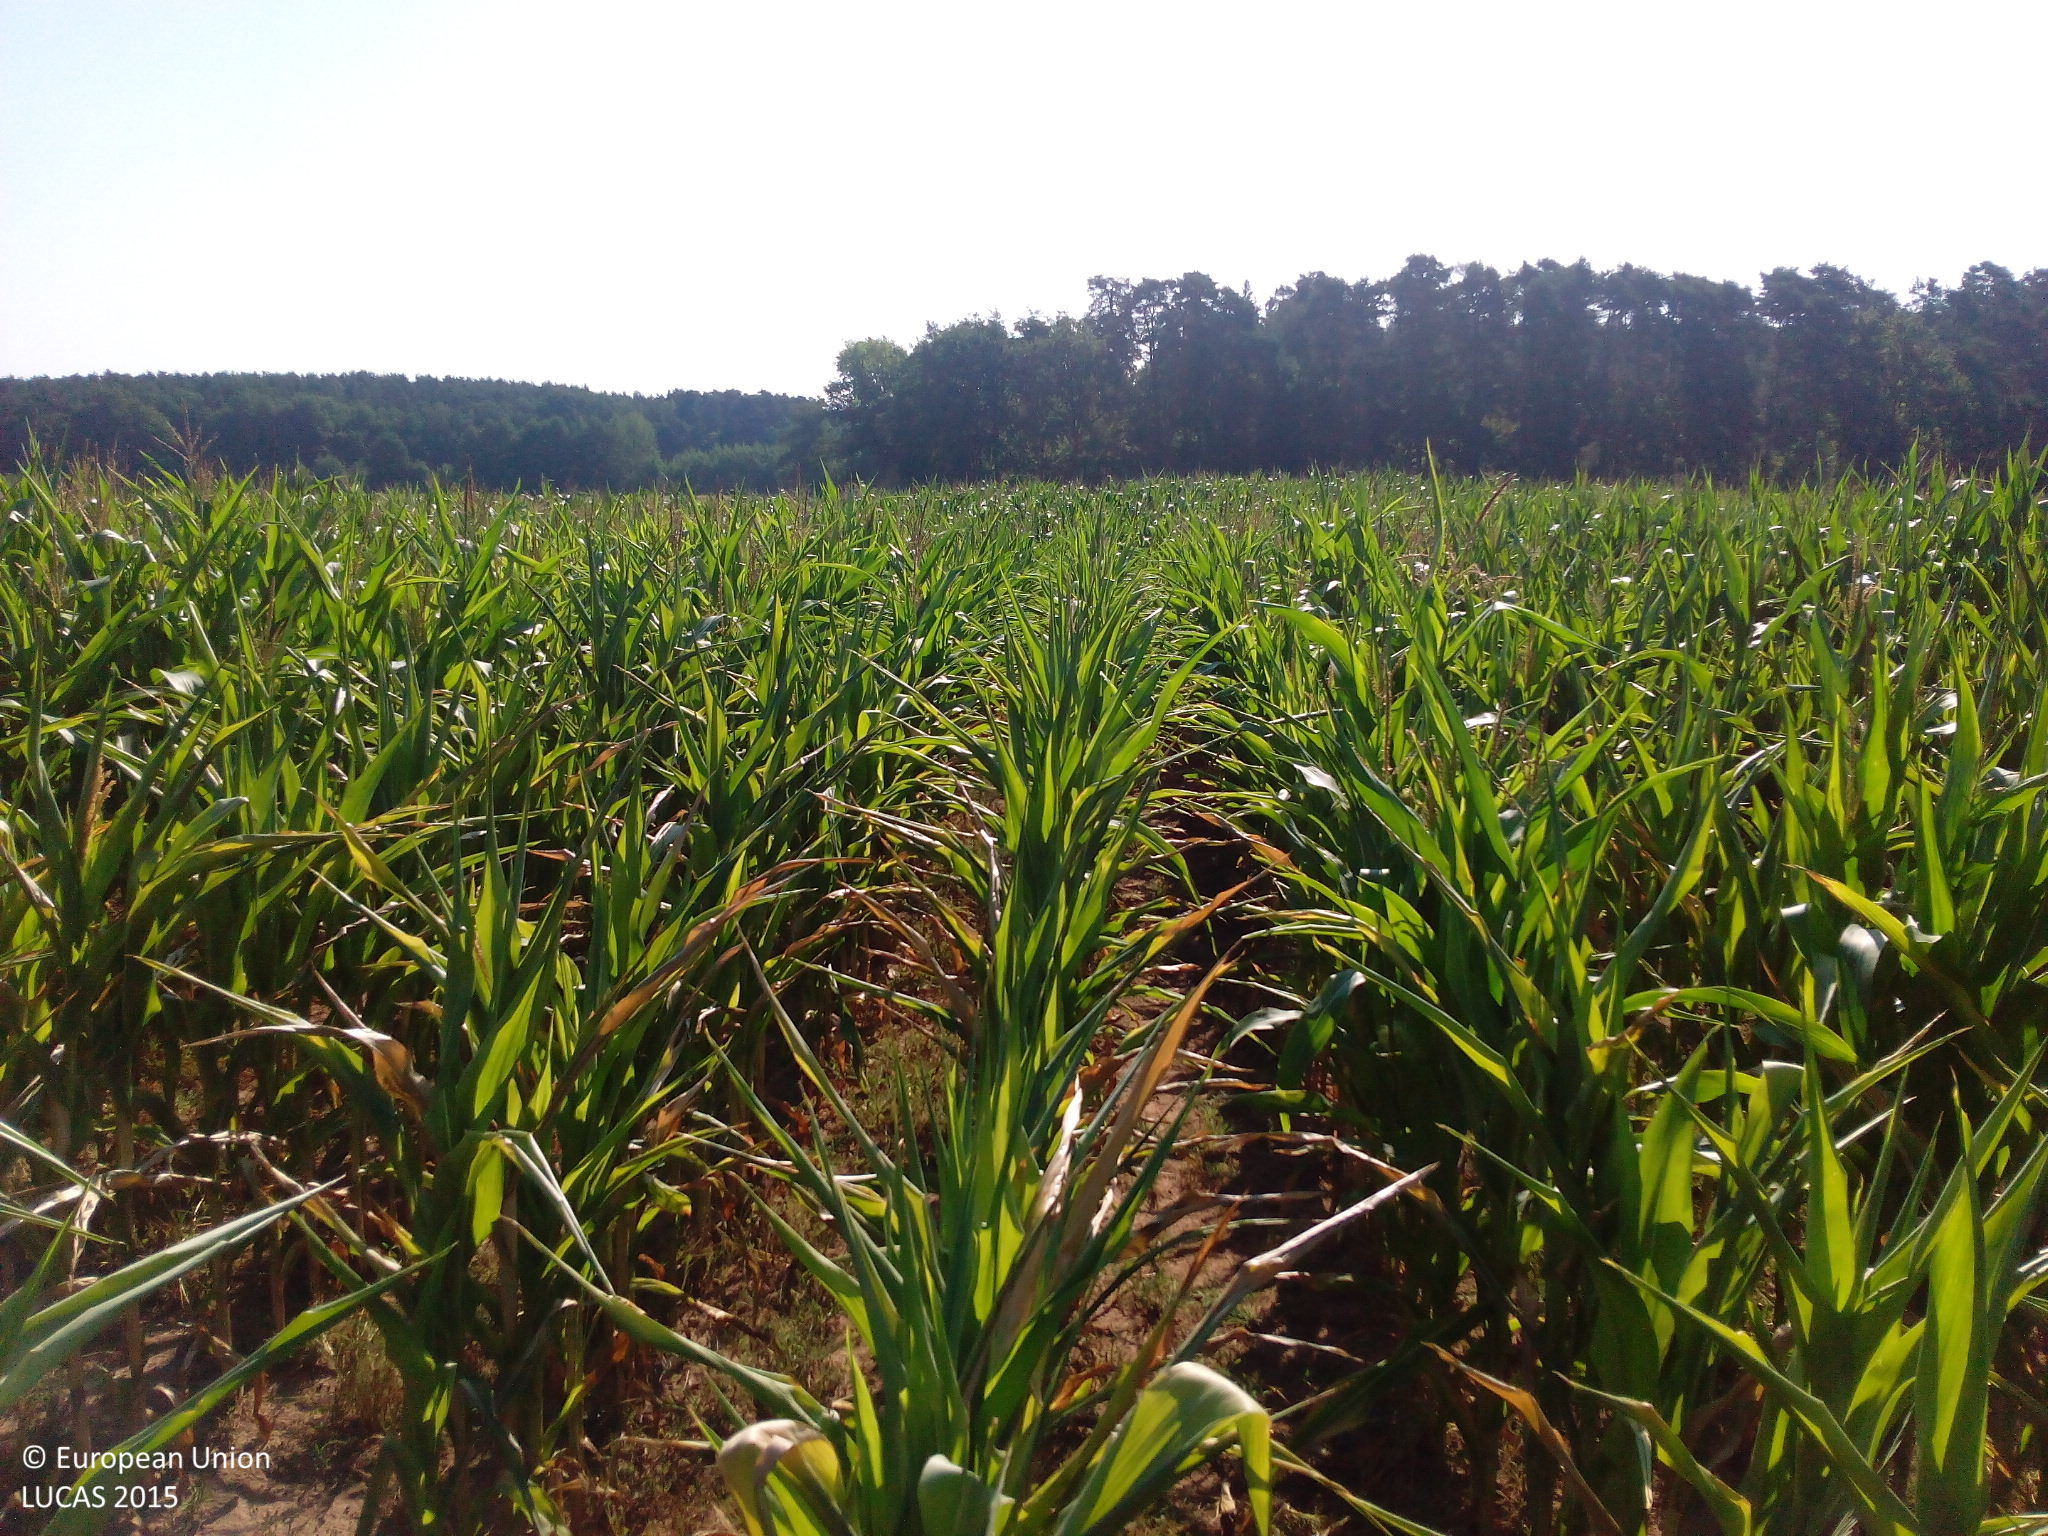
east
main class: Cropland
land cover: Maize
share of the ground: > 75 %
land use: Agriculture (excluding fallow land and kitchen gardens)
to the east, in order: Maize; Grass margins; Temporary grasslands; Grassland without tree/shrub cover; Fences; Grassland without tree/shrub cover; Fences; Grassland without tree/shrub cover; Broadleaved woodland; Ditches and canals; Grass margins; Tracks; Grassland without tree/shrub cover
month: July
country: DE
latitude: 49.6577
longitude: 11.0663
